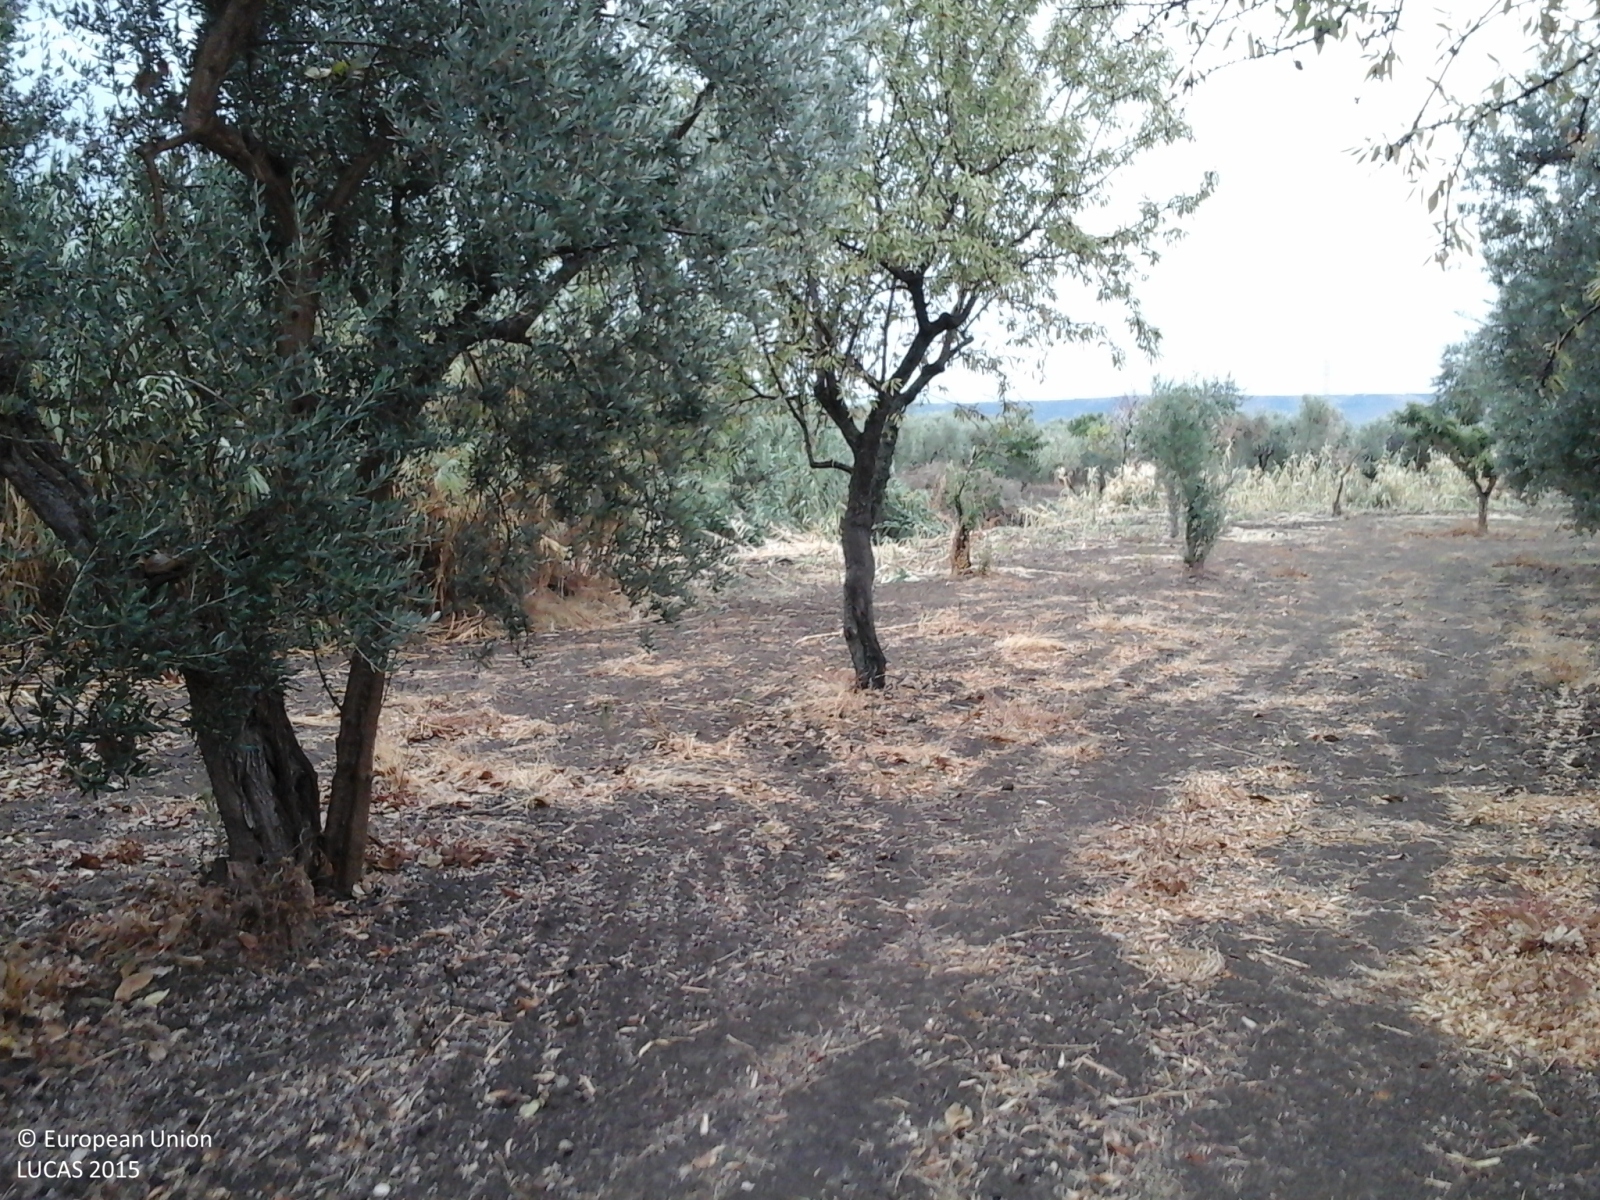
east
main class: Cropland
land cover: Olive groves
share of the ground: > 75 %
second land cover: Other bare soil
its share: > 75 %
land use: Agriculture (excluding fallow land and kitchen gardens)
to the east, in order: Olive groves; Other bare soil; Olive groves; Shrubland without tree cover; Ditches and canals; Shrubland without tree cover; Olive groves; Electric lines; Olive groves
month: September
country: IT
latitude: 41.7980
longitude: 15.1708
